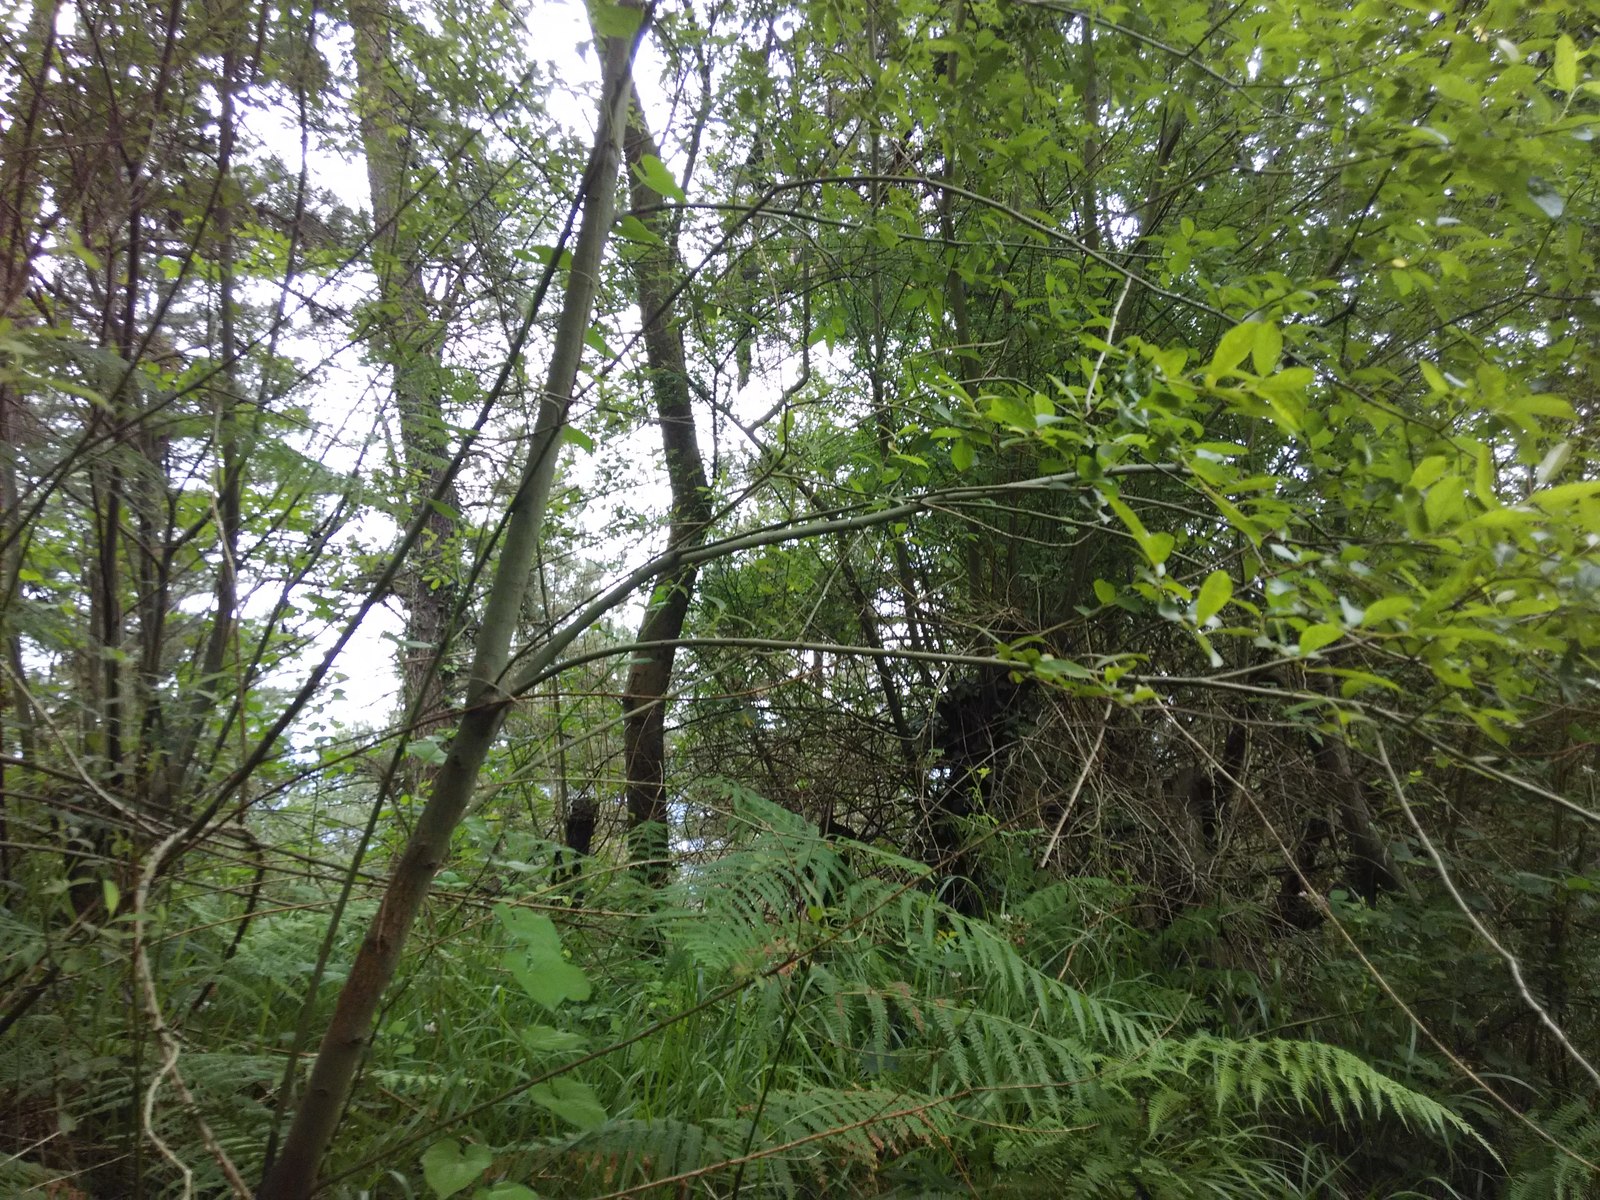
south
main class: Woodland
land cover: Pine dominated coniferous woodland
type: exotic forest
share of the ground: > 75 %
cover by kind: coniferous forest trees 80 %, shrubs 15 %, unconsolidated bare surface 5 %
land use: Forestry
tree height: > 5 m
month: July
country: ES
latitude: 43.1023
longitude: -2.4735
